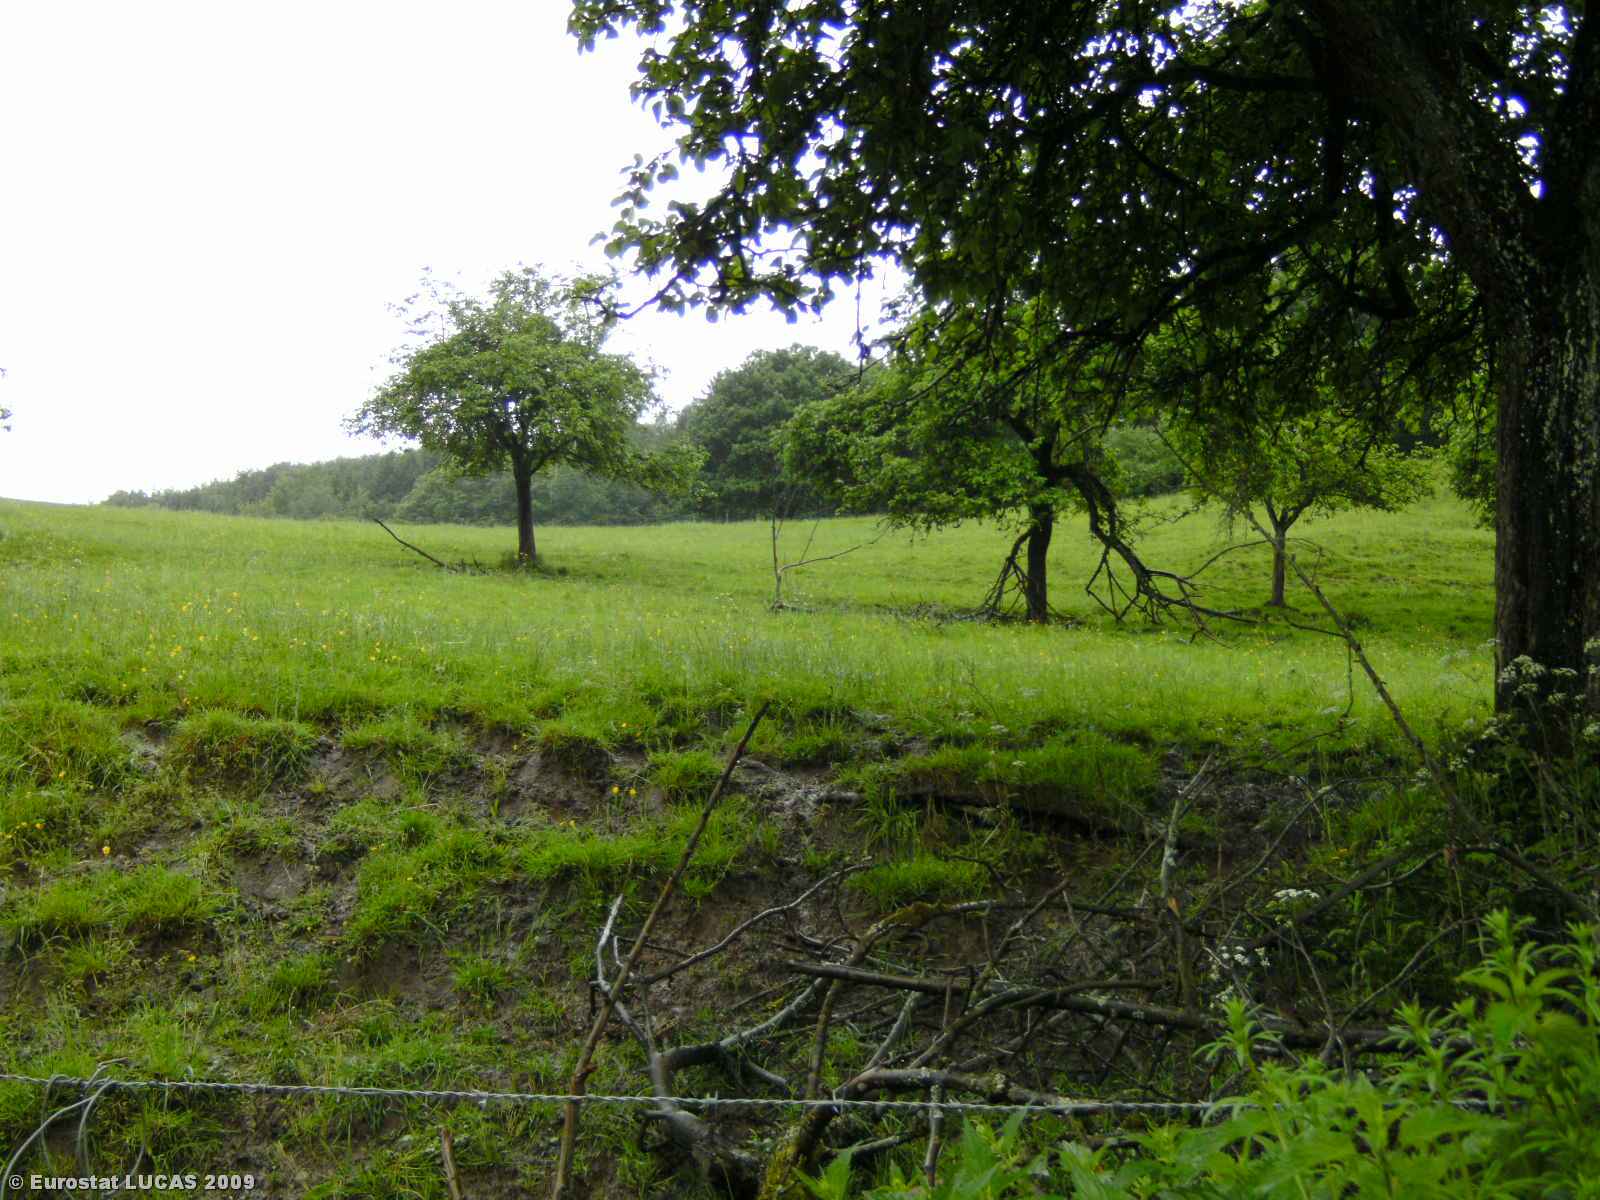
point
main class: Grassland
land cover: Grassland without tree/shrub cover
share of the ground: > 75 %
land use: Agriculture (excluding fallow land and kitchen gardens)
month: May
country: LU
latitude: 49.8547
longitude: 6.3136
